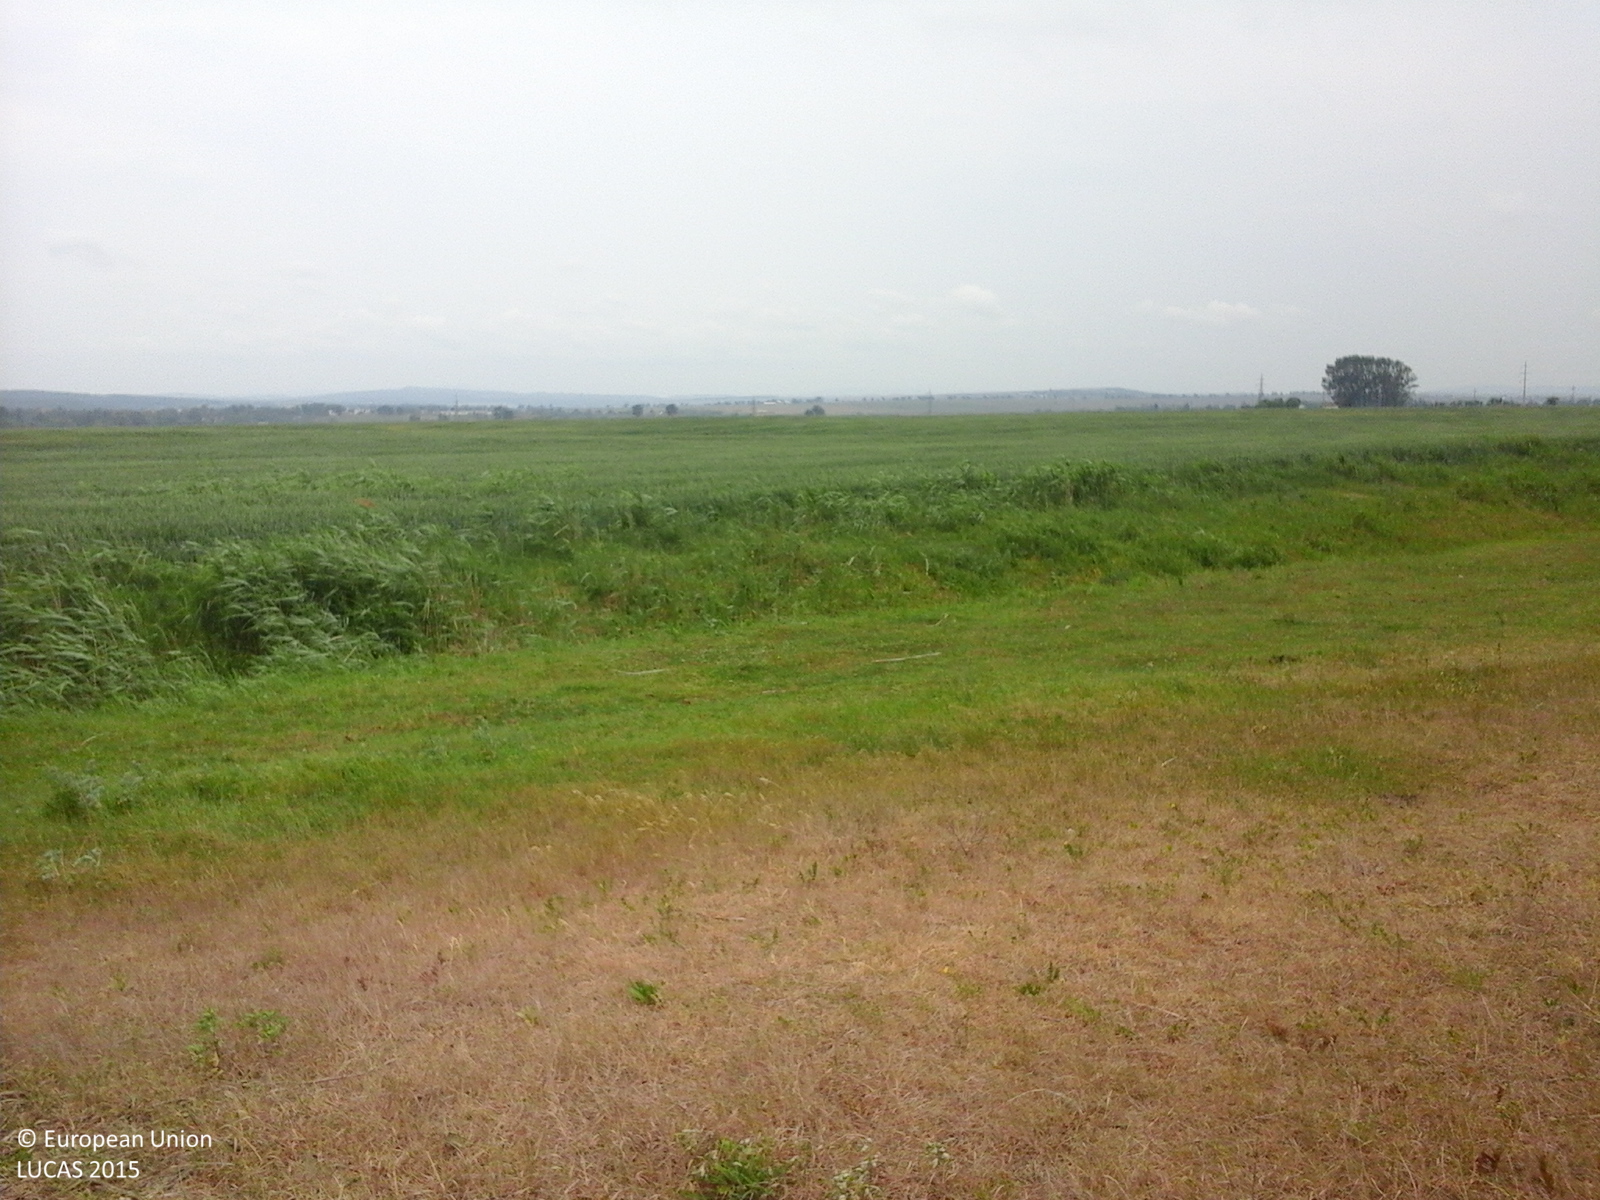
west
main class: Cropland
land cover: Other leguminous and mixtures for fodder
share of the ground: > 75 %
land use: Agriculture (excluding fallow land and kitchen gardens)
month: June
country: RO
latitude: 47.0884
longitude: 26.6756
